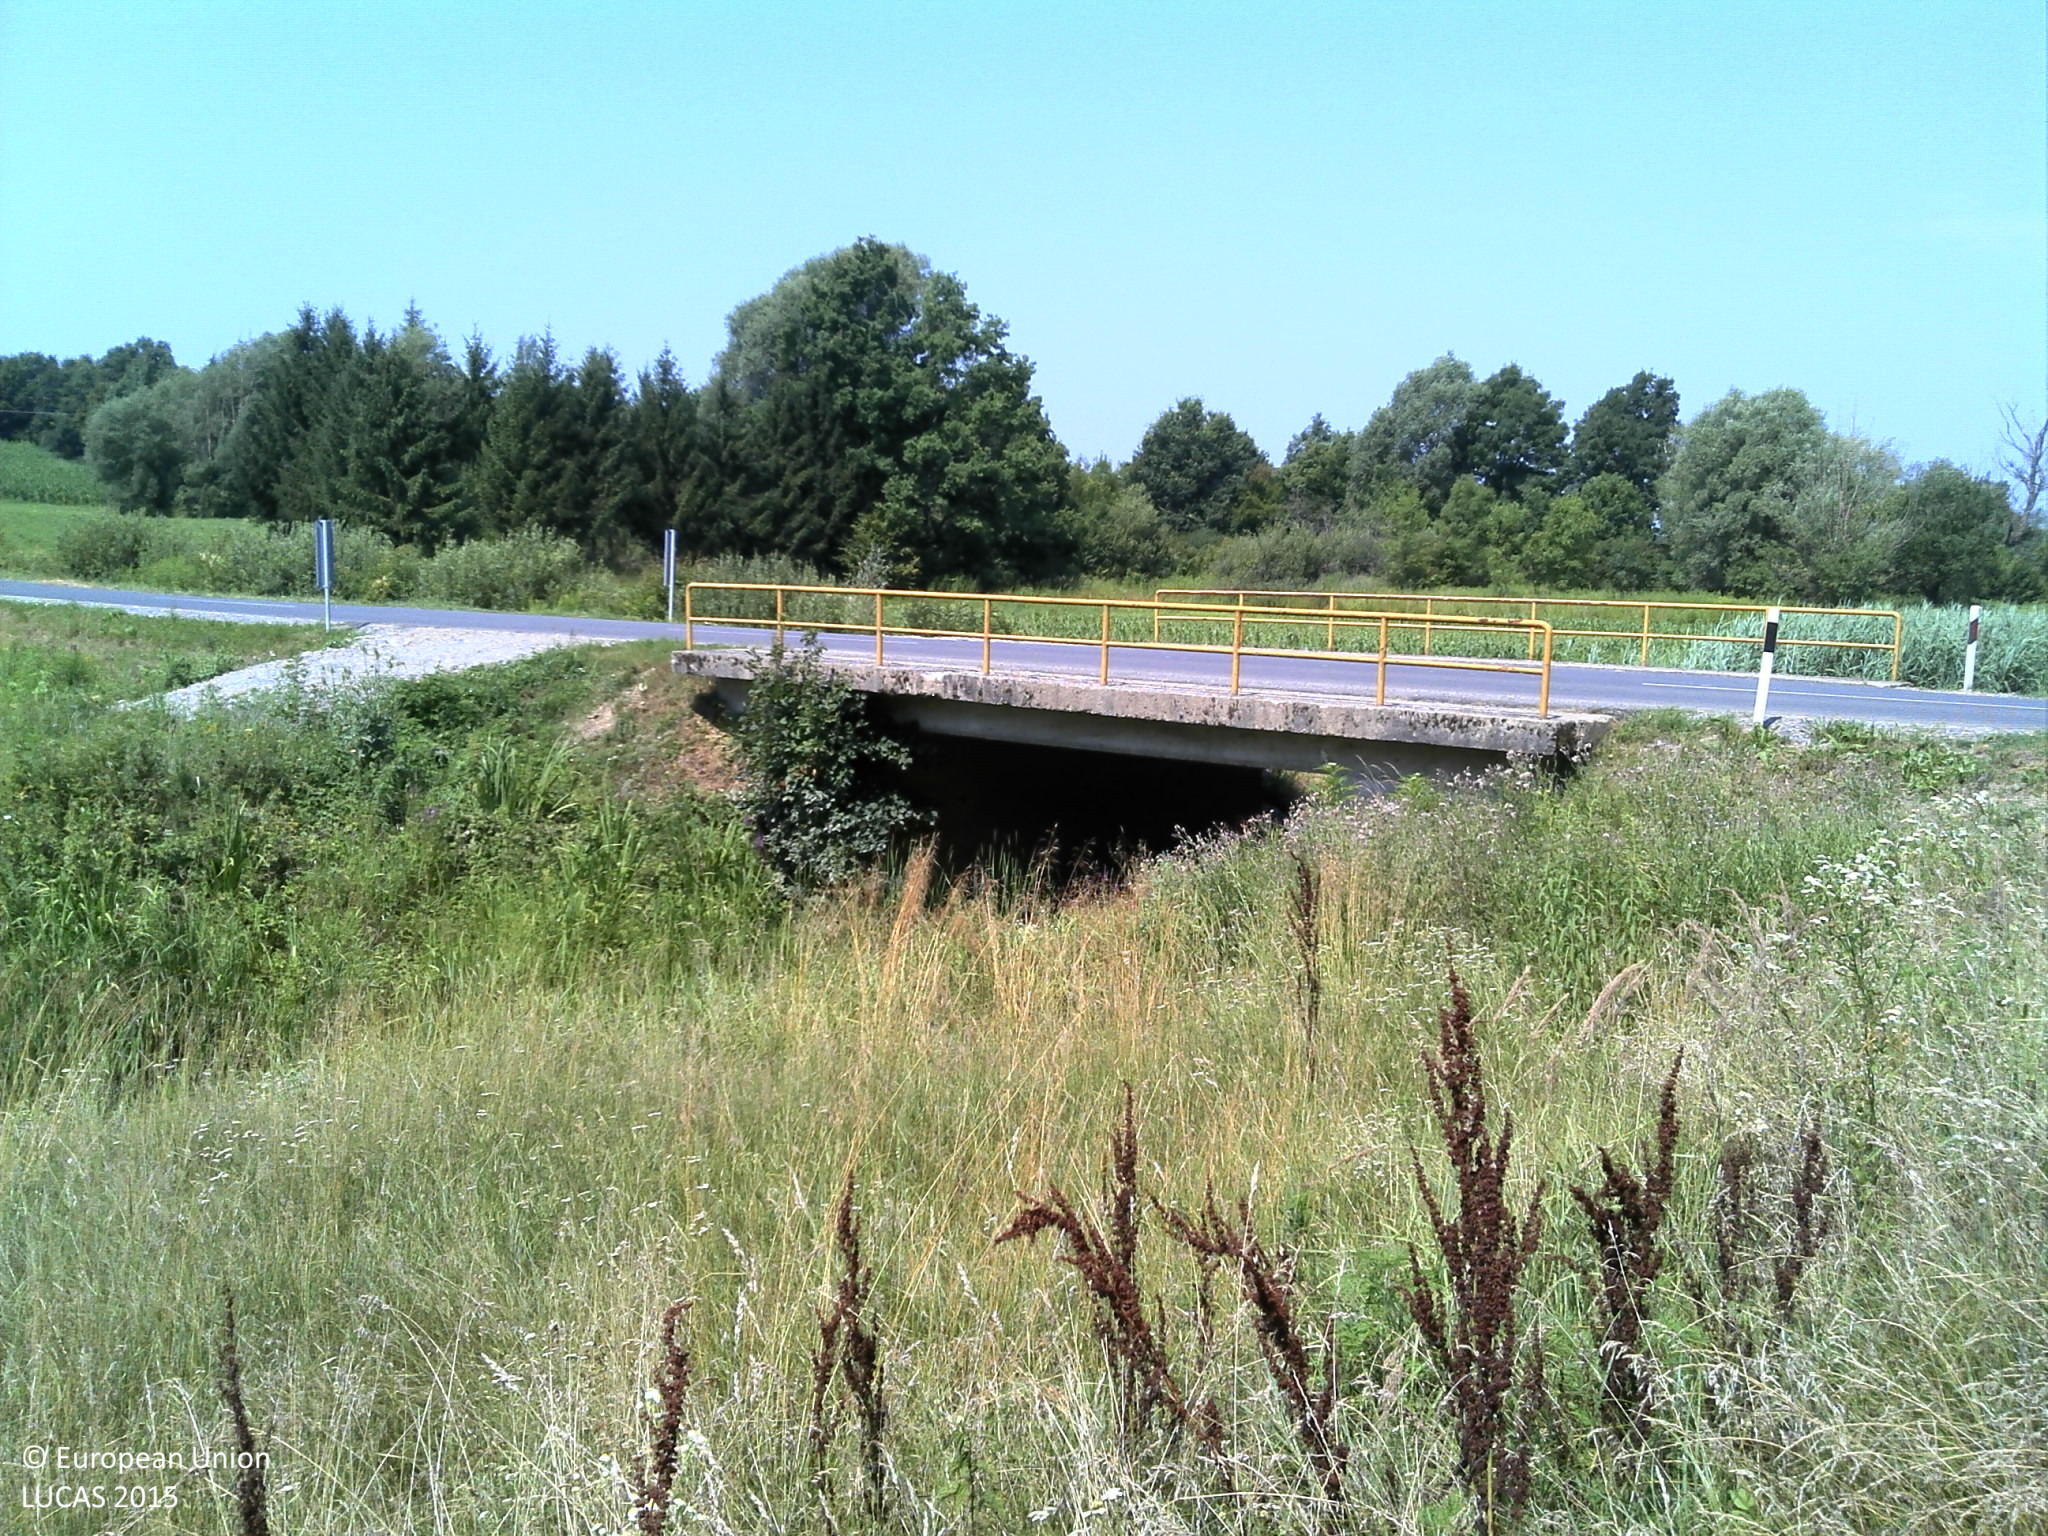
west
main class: Grassland
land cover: Spontaneously vegetated surfaces
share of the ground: > 75 %
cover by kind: herbaceous plants 100 %
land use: Fallow land
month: July
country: HR
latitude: 45.7876
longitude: 16.5724
